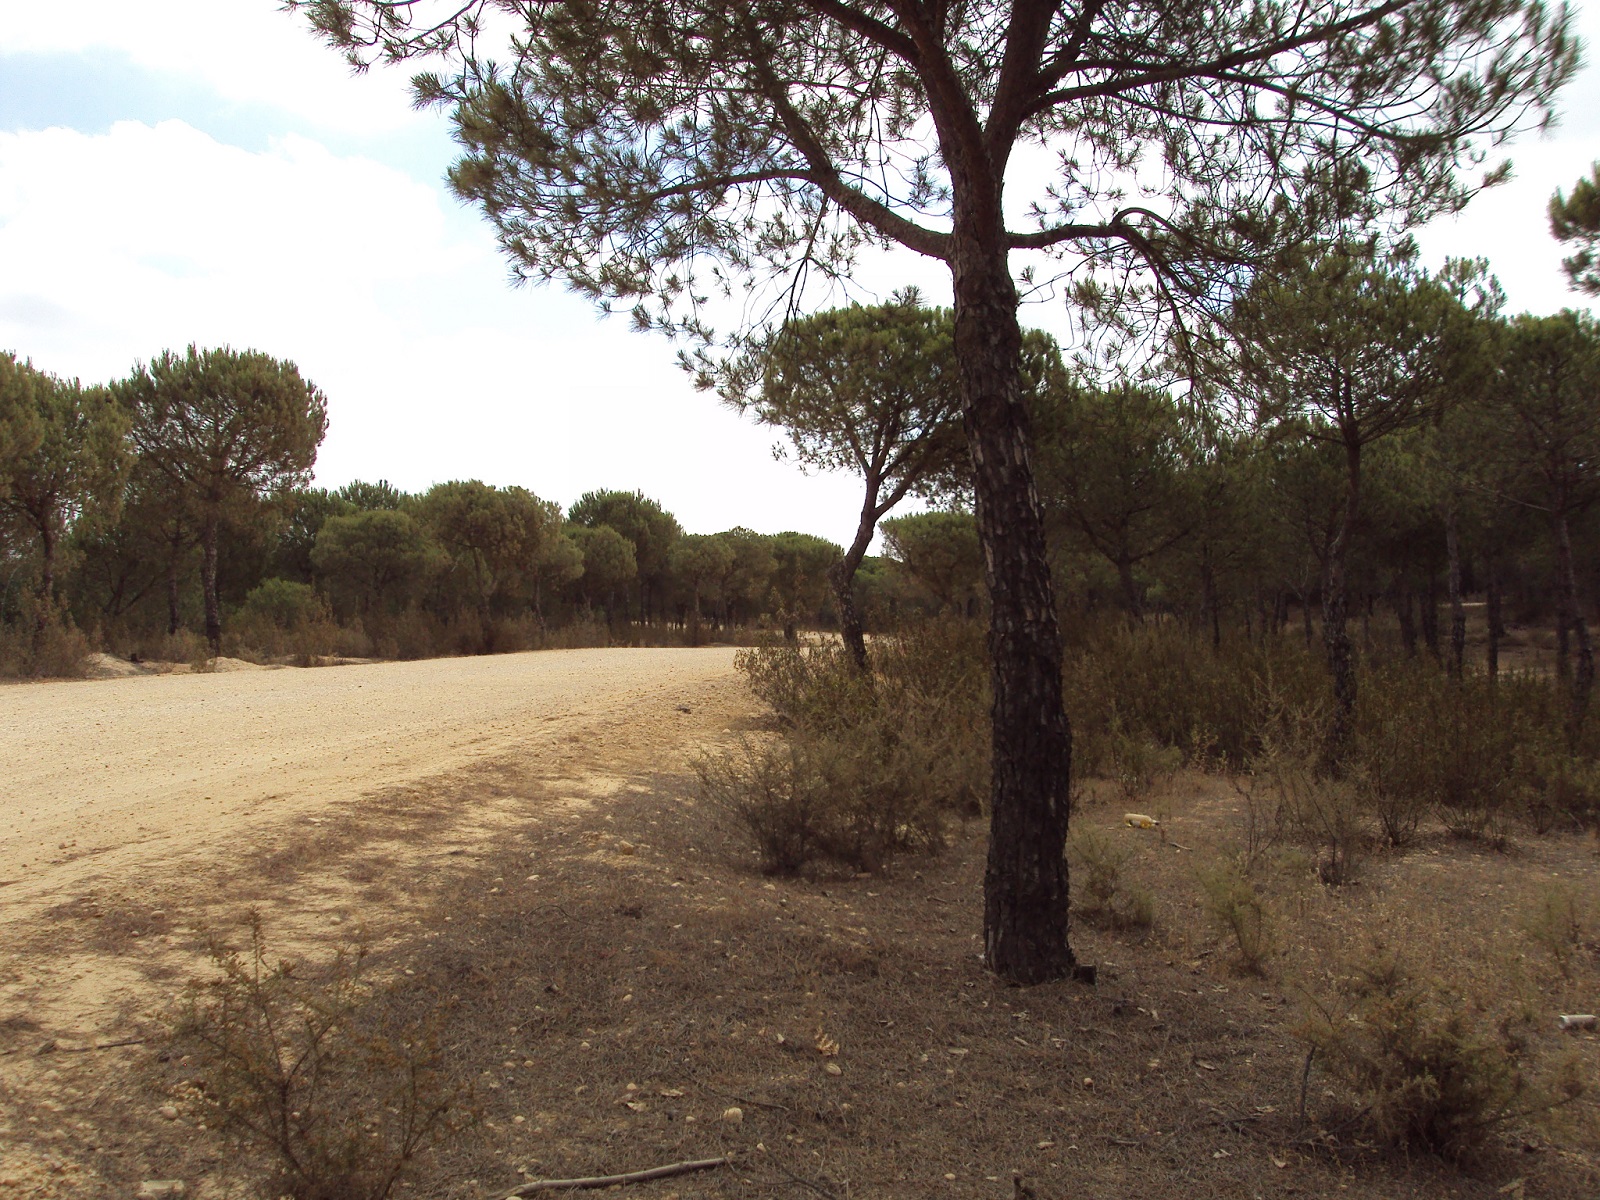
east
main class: Woodland
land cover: Pine dominated coniferous woodland
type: coniferous forest of the mediterranean region
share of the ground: 50 - 75 %
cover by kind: coniferous forest trees 60 %, herbaceous plants 30 %, shrubs 10 %
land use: Forestry
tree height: > 5 m
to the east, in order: Pine dominated coniferous woodland; Tracks; Pine dominated coniferous woodland; Tracks; Pine dominated coniferous woodland
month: June
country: ES
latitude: 37.2273
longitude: -6.8630
